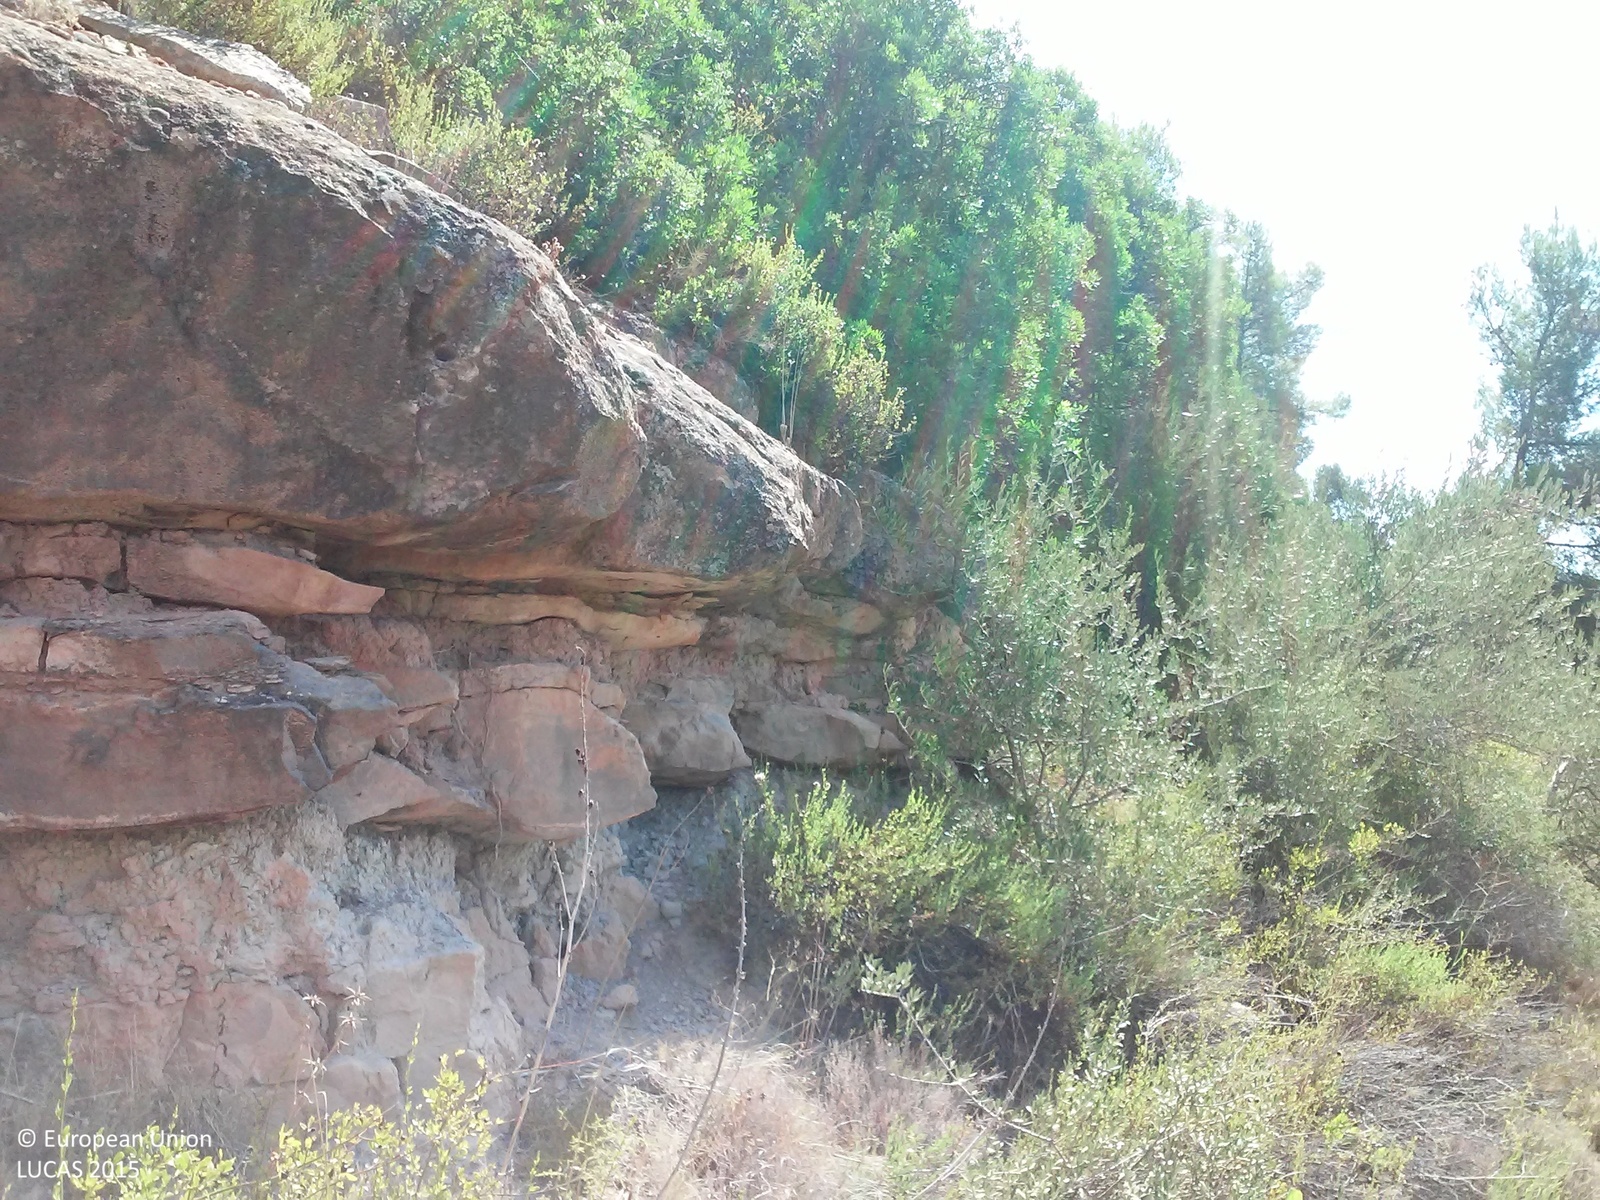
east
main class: Cropland
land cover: Olive groves
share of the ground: < 10 %
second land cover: Shrubland without tree cover
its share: > 75 %
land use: Abandoned areas
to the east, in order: Tracks; Olive groves; Shrubland without tree cover; Pine dominated coniferous woodland; Tracks; Pine dominated coniferous woodland; Tracks; Nuts trees; Dry stone walls; Nuts trees; Dry stone walls; Nuts trees; Dry stone walls; Nuts trees; Dry stone walls; Nuts trees; Dry stone walls; Nuts trees; Dry stone walls; Nuts trees; Dry stone walls; Nuts trees; Dry stone walls; Nuts trees
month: August
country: ES
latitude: 41.1157
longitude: 0.4994
